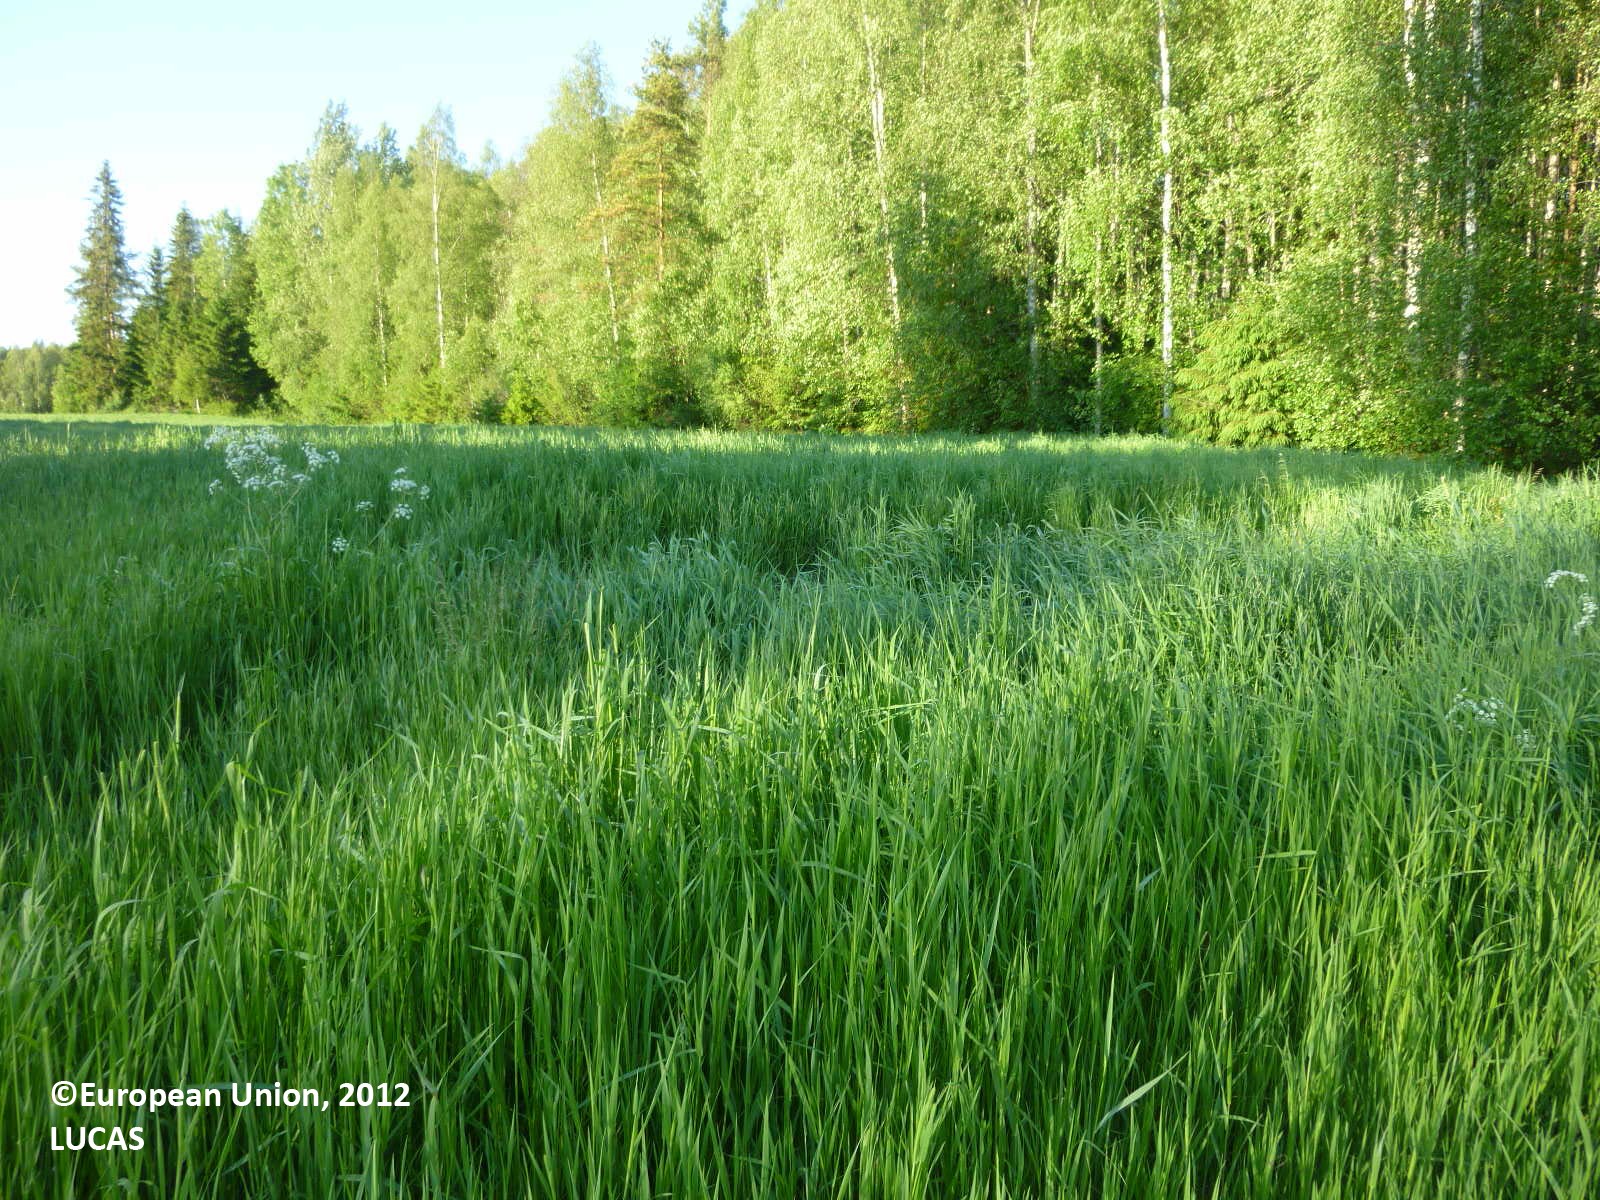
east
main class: Cropland
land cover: Temporary grasslands
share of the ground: > 75 %
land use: Agriculture (excluding fallow land and kitchen gardens)
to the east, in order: Temporary grasslands; Spruce dominated mixed woodland; Temporary grasslands; Grassland without tree/shrub cover; Oats; Grass margins; Ditches and canals; Grass margins; Other mixed woodland
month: June
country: FI
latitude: 61.6458
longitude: 22.1183
